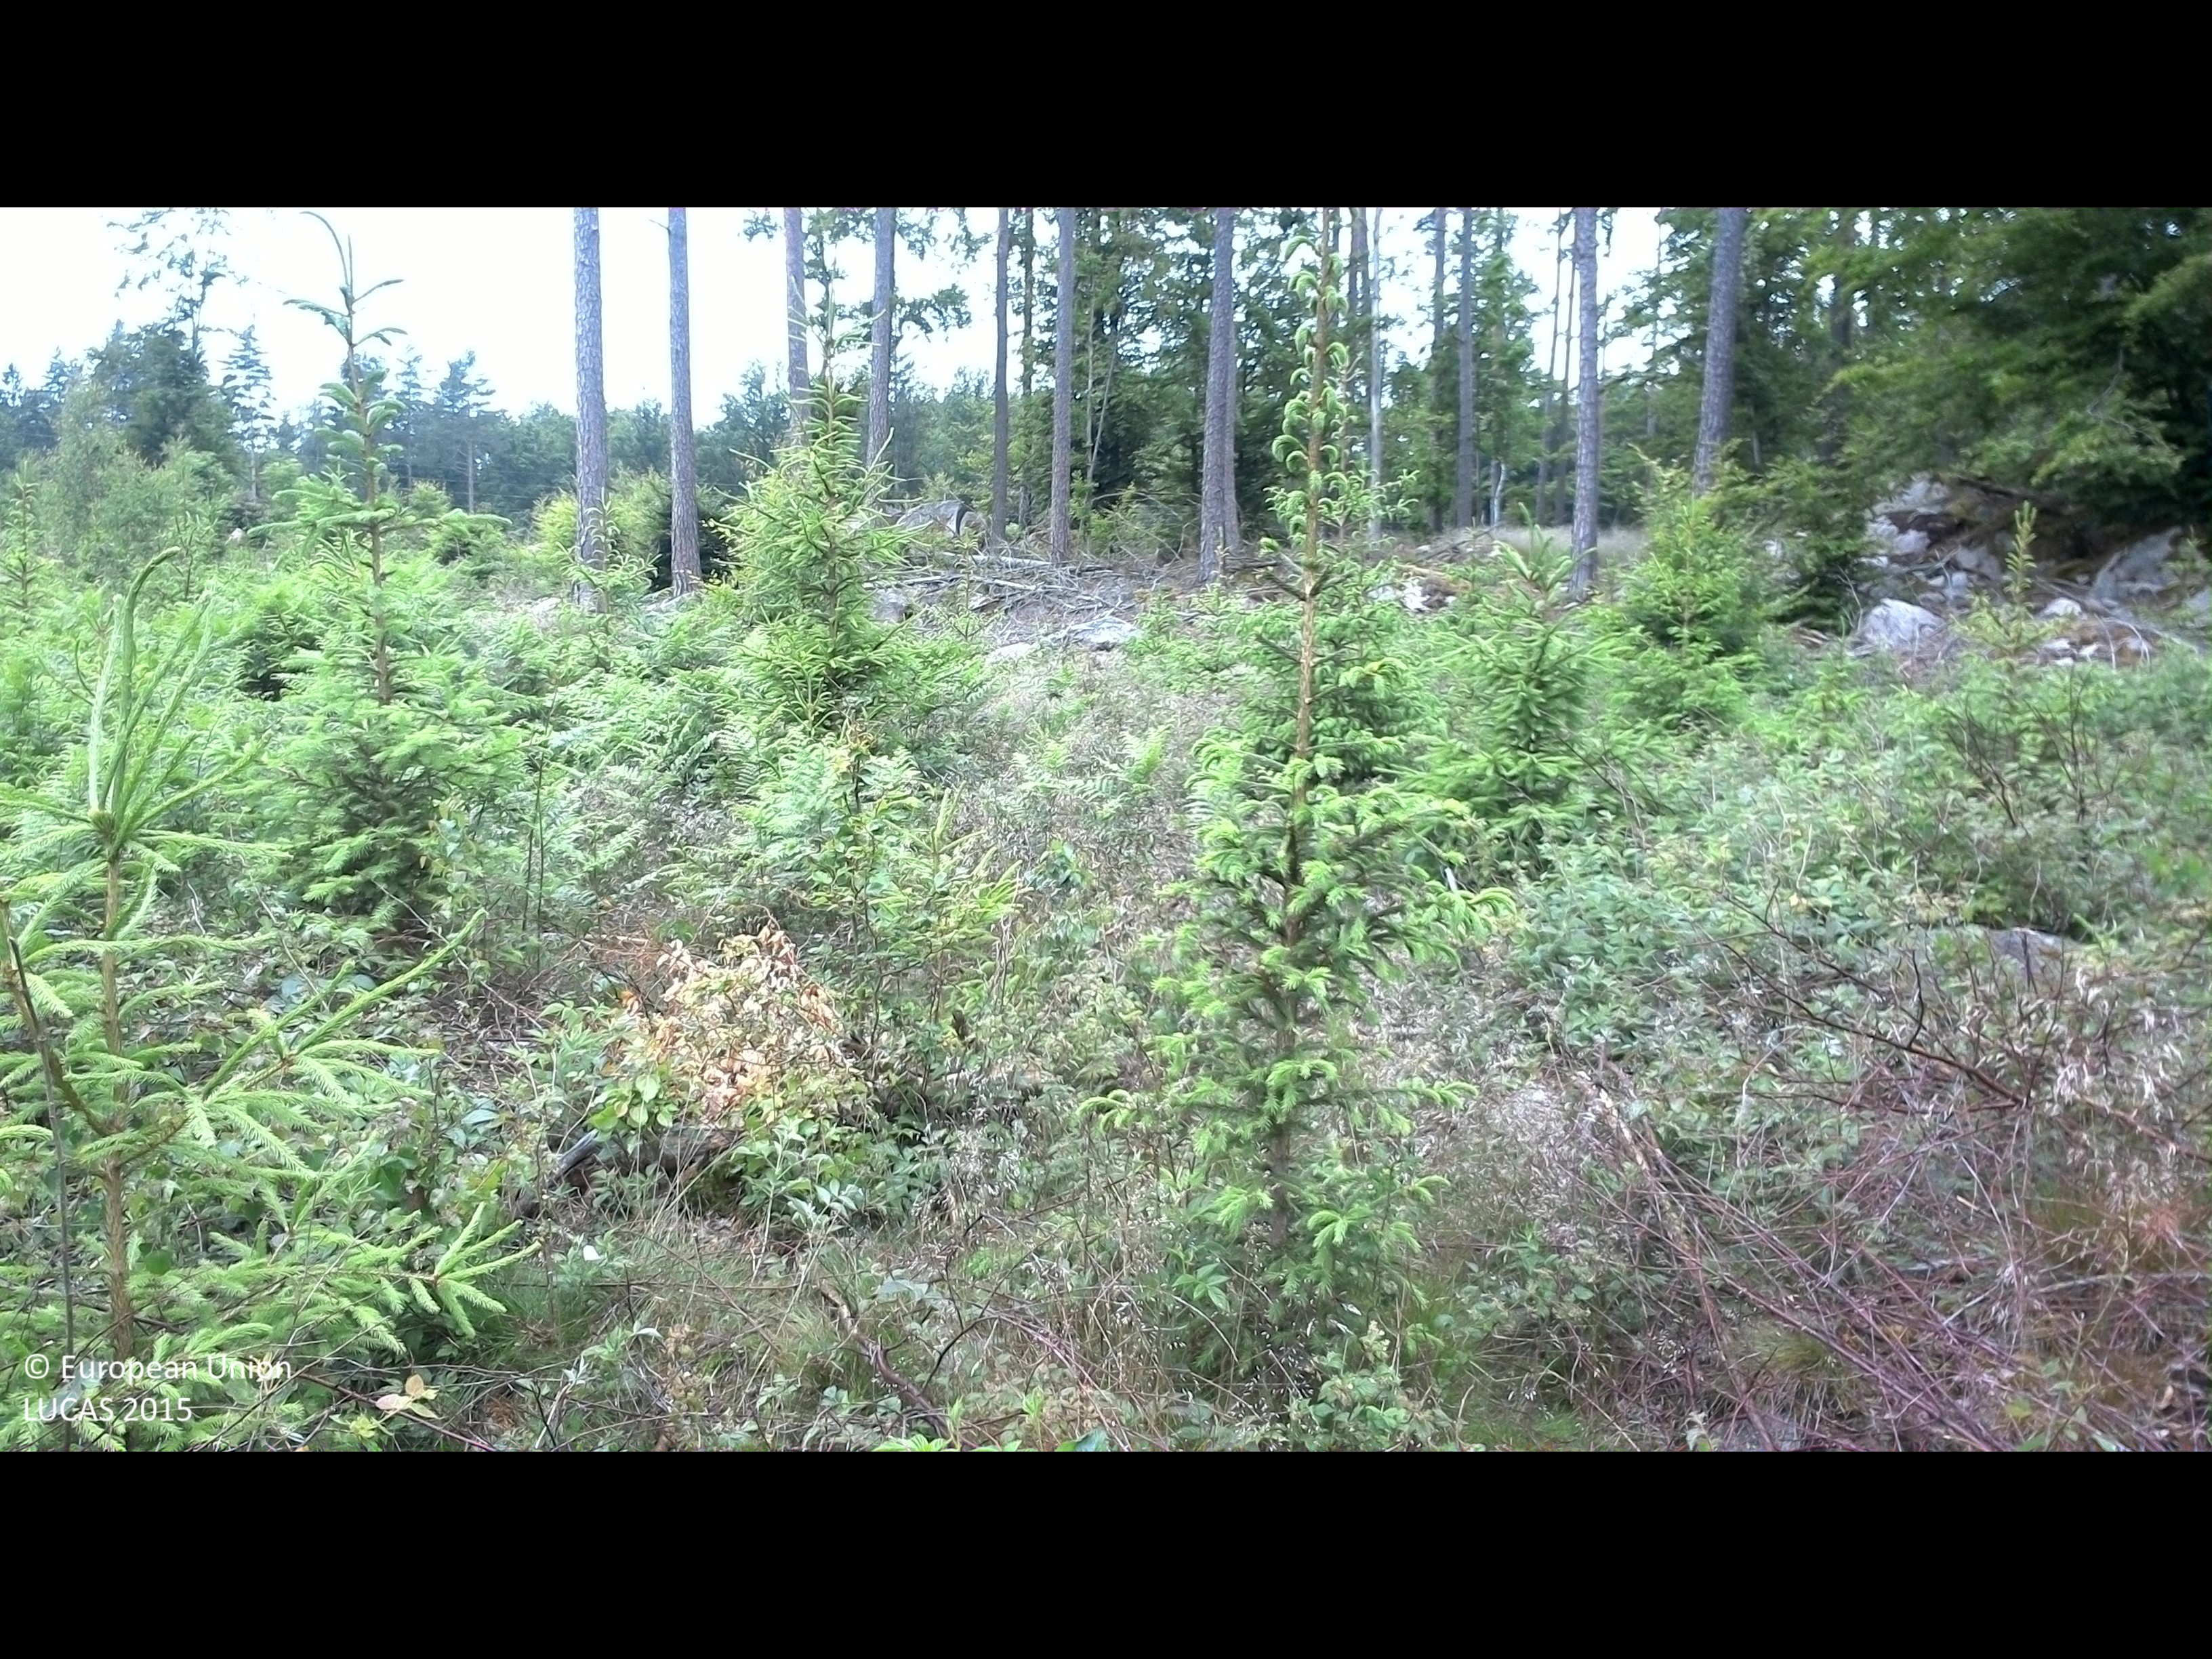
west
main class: Woodland
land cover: Spruce dominated mixed woodland
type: boreal forest
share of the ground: 25 - 50 %
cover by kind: coniferous forest trees 35 %, shrubs 30 %, herbaceous plants 20 %, broadleaved forest trees 15 %
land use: Forestry
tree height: < 5 m
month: June
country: SE
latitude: 56.4478
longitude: 15.9215
